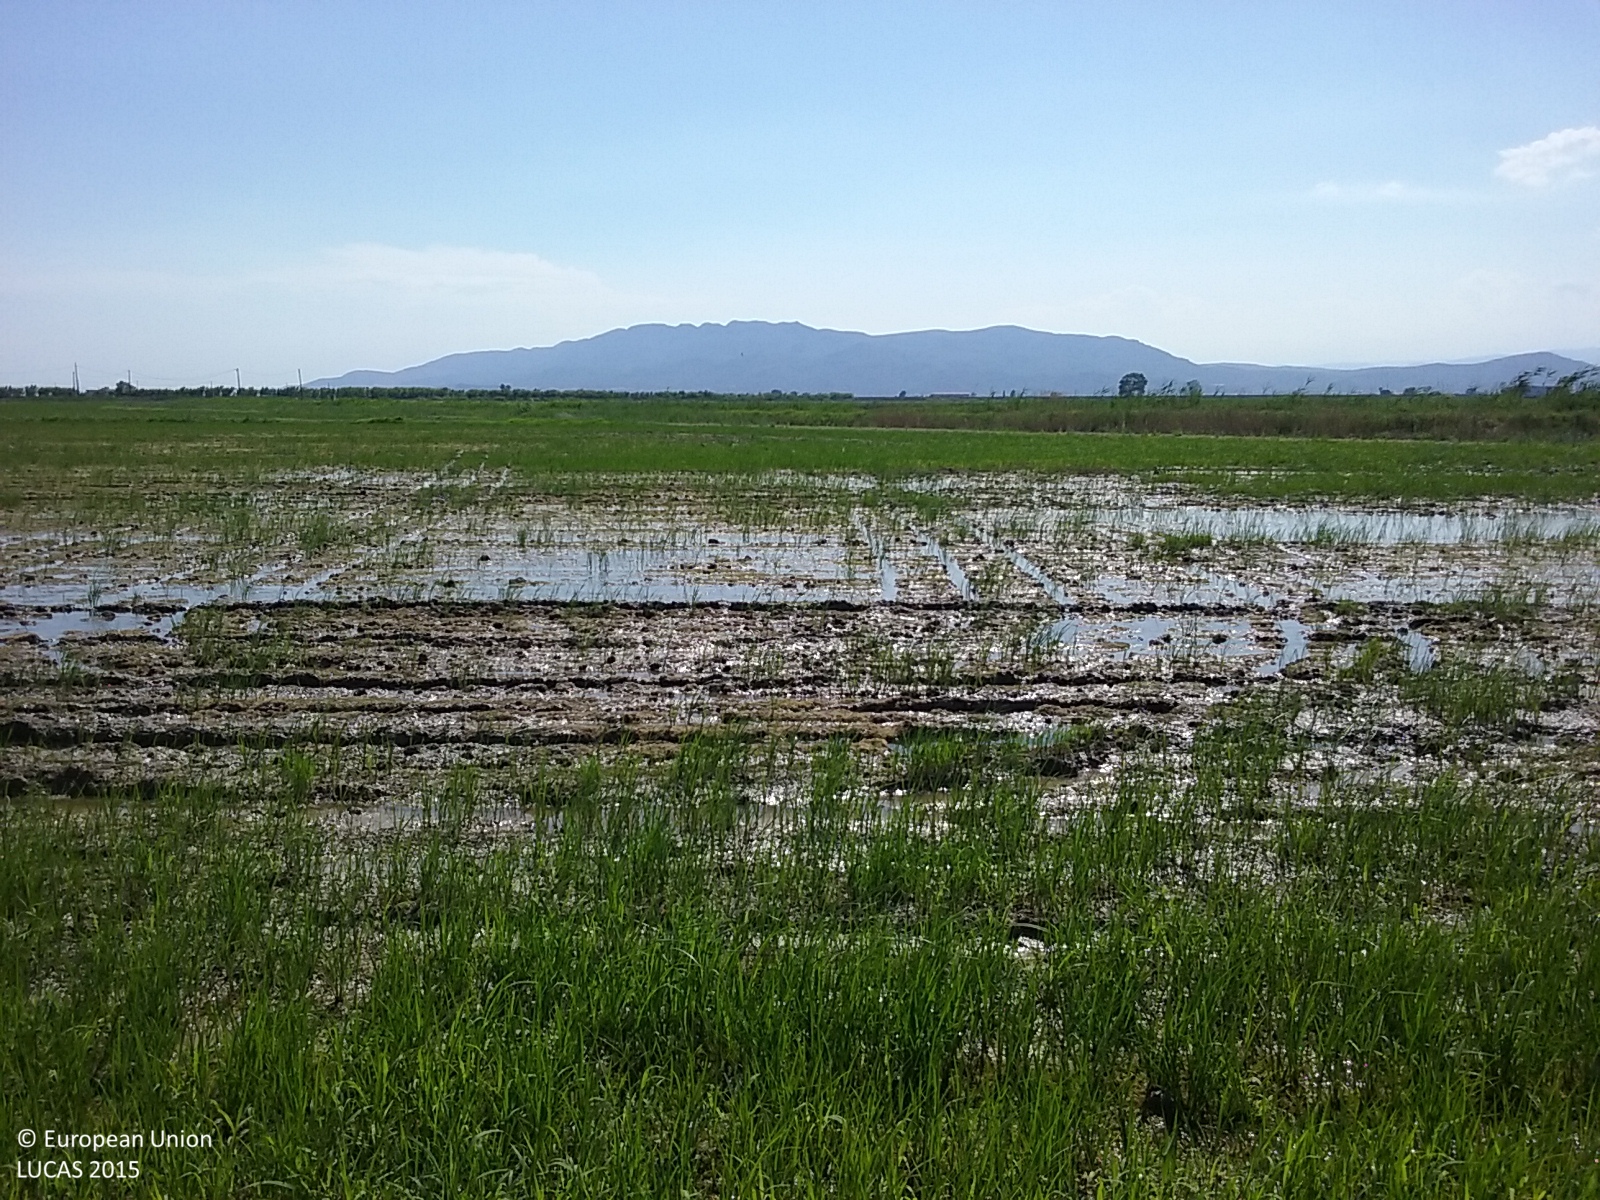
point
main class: Cropland
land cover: Rice
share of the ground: 50 - 75 %
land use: Agriculture (excluding fallow land and kitchen gardens)
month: June
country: ES
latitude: 40.6785
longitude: 0.6845
